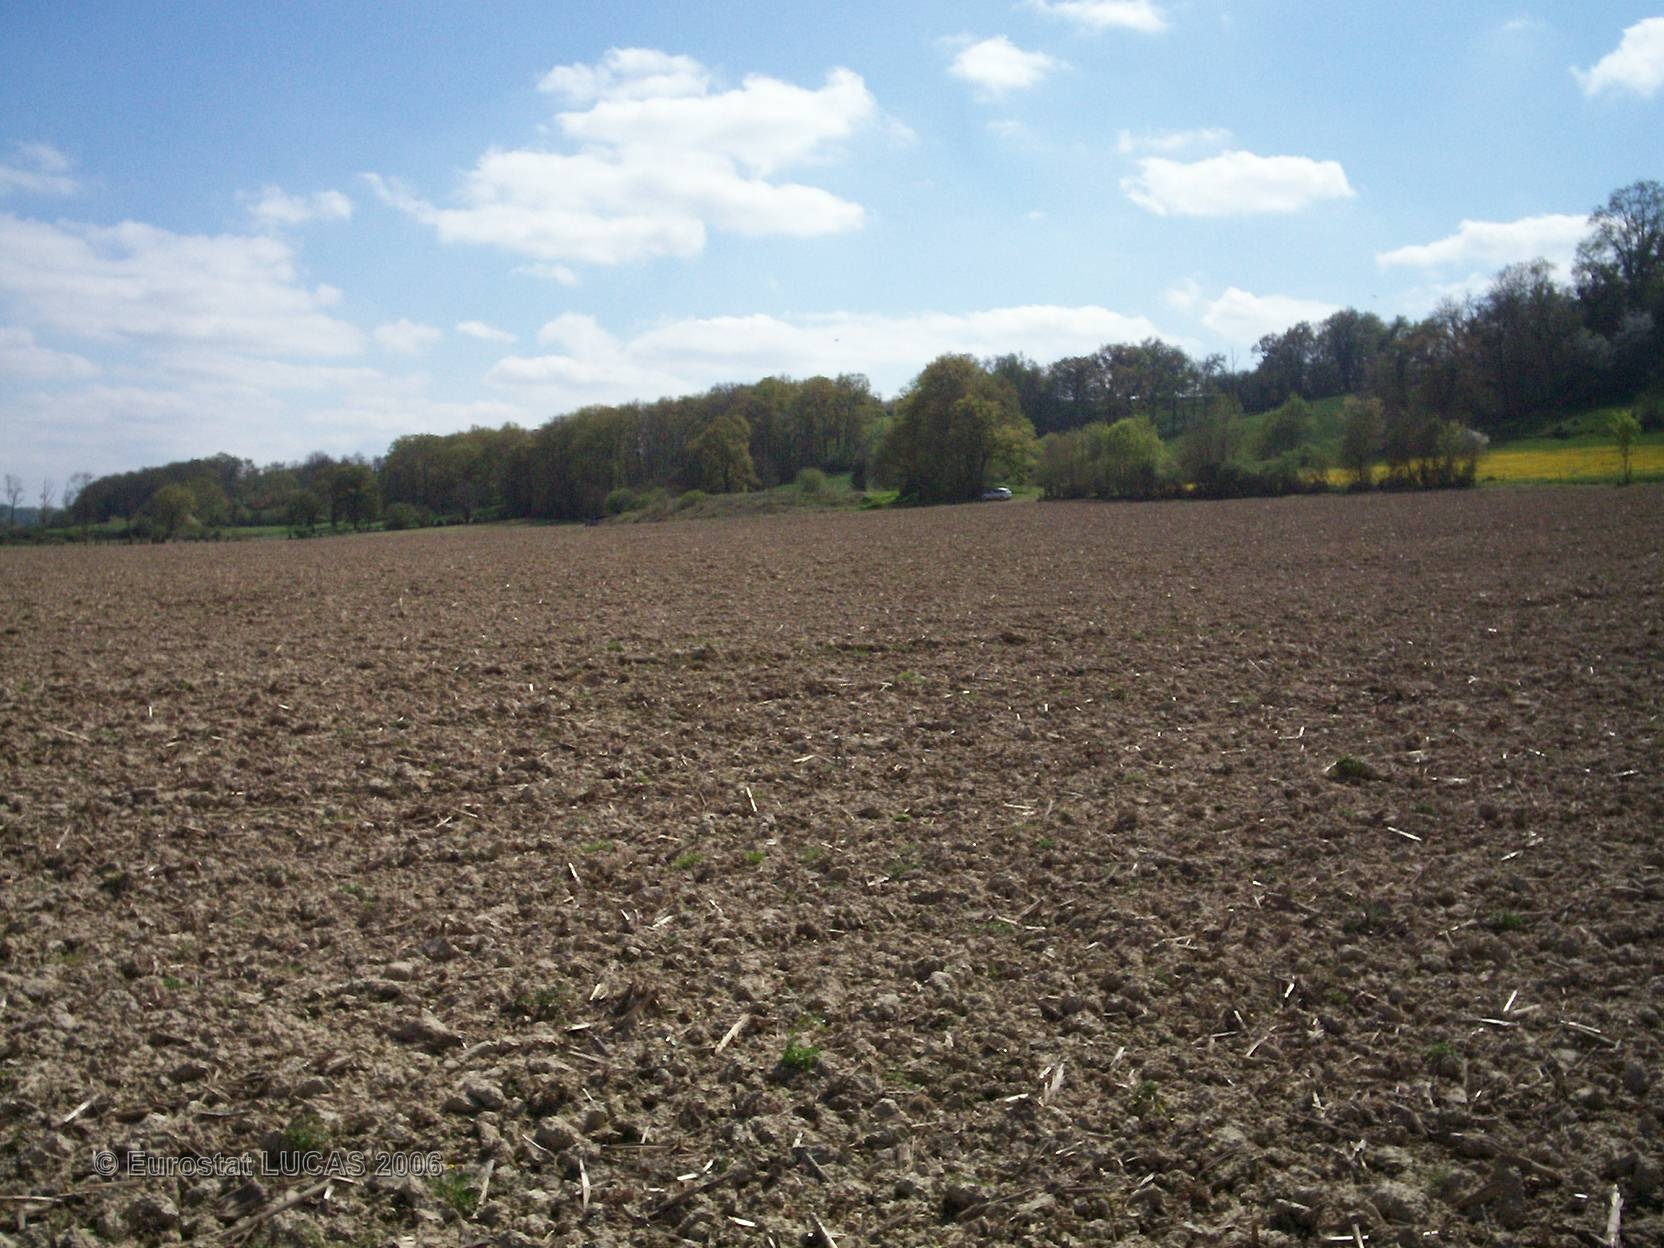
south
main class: Cropland
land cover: Maize
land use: Agriculture (excluding fallow land and kitchen gardens)
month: June
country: FR
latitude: 43.5238
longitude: -0.3390
